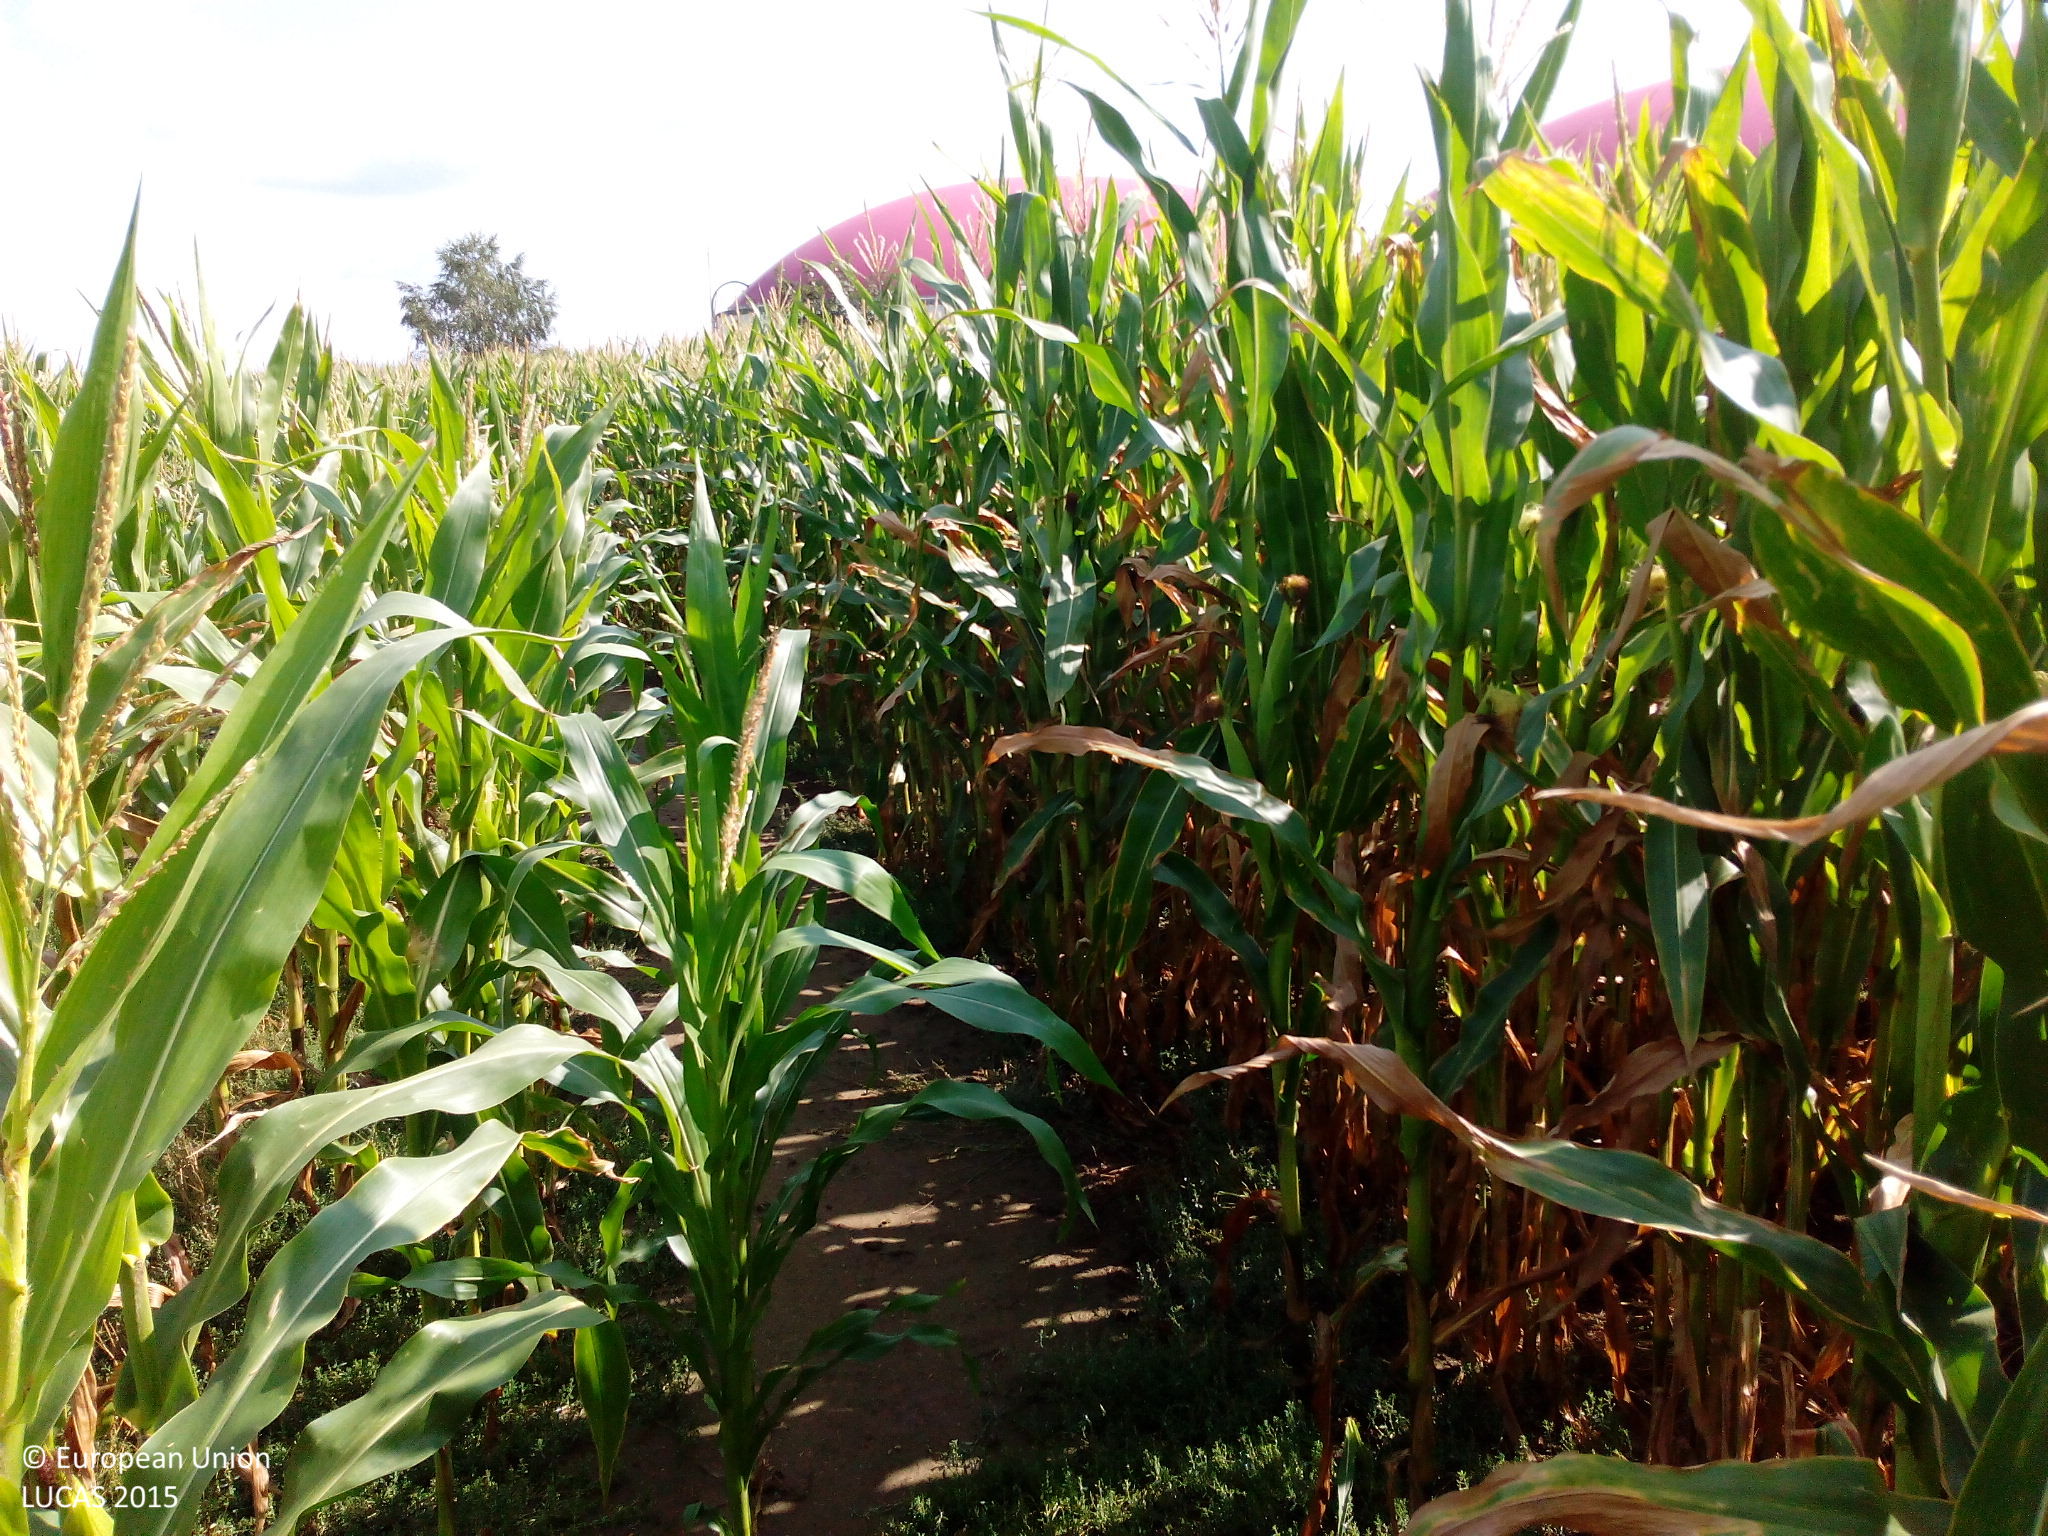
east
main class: Cropland
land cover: Maize
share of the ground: > 75 %
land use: Agriculture (excluding fallow land and kitchen gardens)
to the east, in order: Maize; Artificial constructions in urban areas; Maize; Tracks; Grass margins; Rape and turnip rape
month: August
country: DE
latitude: 54.0206
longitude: 12.6396
